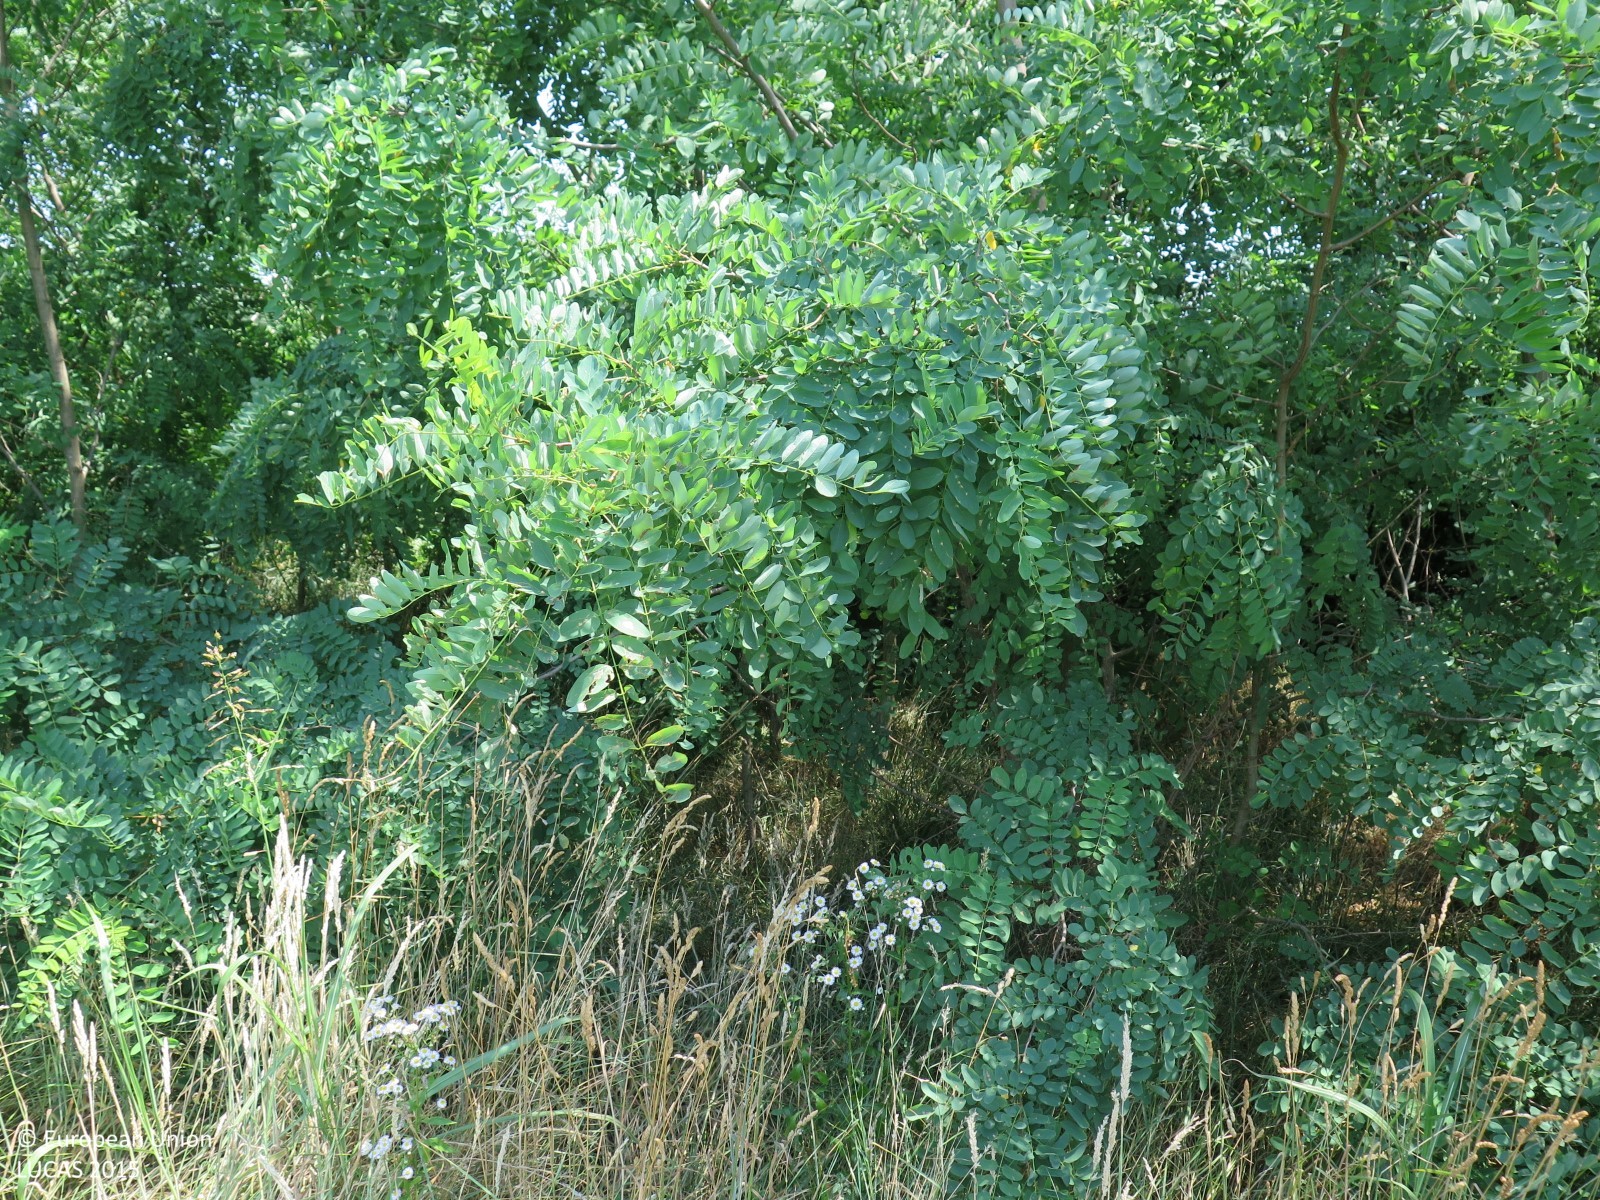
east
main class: Cropland
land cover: Temporary grasslands
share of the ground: > 75 %
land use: Agriculture (excluding fallow land and kitchen gardens)
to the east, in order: Temporary grasslands; Shrubland with sparse tree cover; Broadleaved woodland; Shrubland with sparse tree cover; Ditches and canals; Grass margins; Maize; Other fresh vegetables; Other bare soil; Maize; Tomatoes; Other bare soil; Other fresh vegetables; Maize; Other fresh vegetables; Potatoes; Electric lines; Rape and turnip rape; Single bushes/trees; Grass margins; Broadleaved woodland; Other bare soil; Grassland without tree/shrub cover; Broadleaved woodland
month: July
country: HR
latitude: 45.4075
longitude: 13.5855
